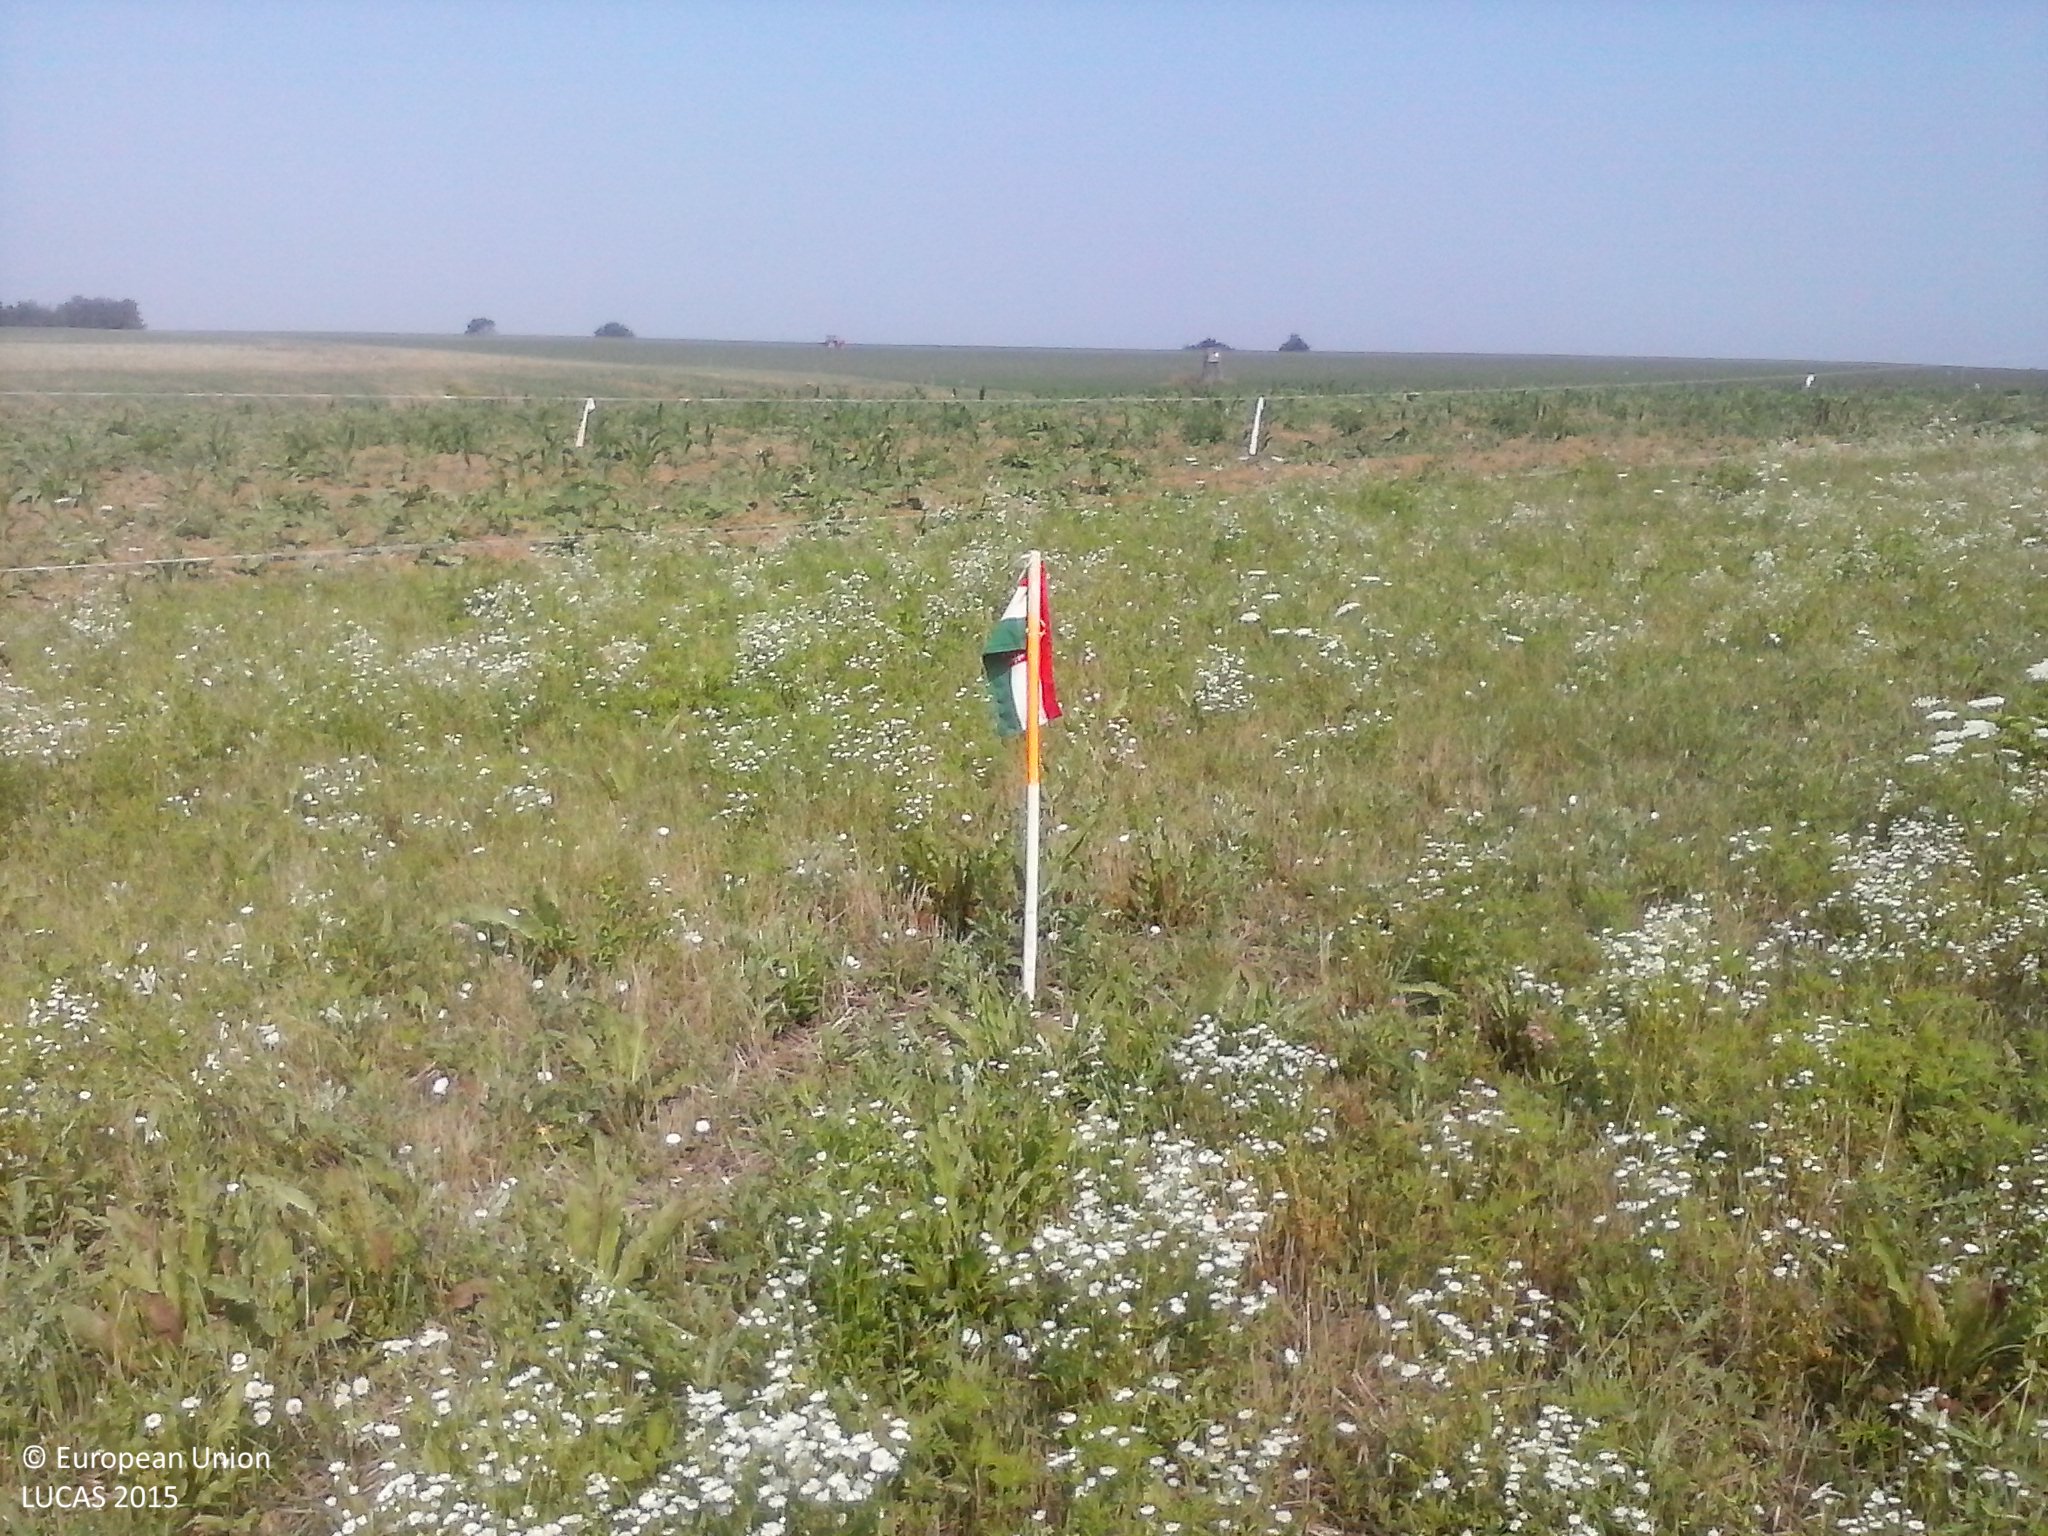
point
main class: Grassland
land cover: Spontaneously vegetated surfaces
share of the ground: > 75 %
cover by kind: herbaceous plants 100 %
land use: Fallow land
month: August
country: HU
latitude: 46.1735
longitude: 17.8160
